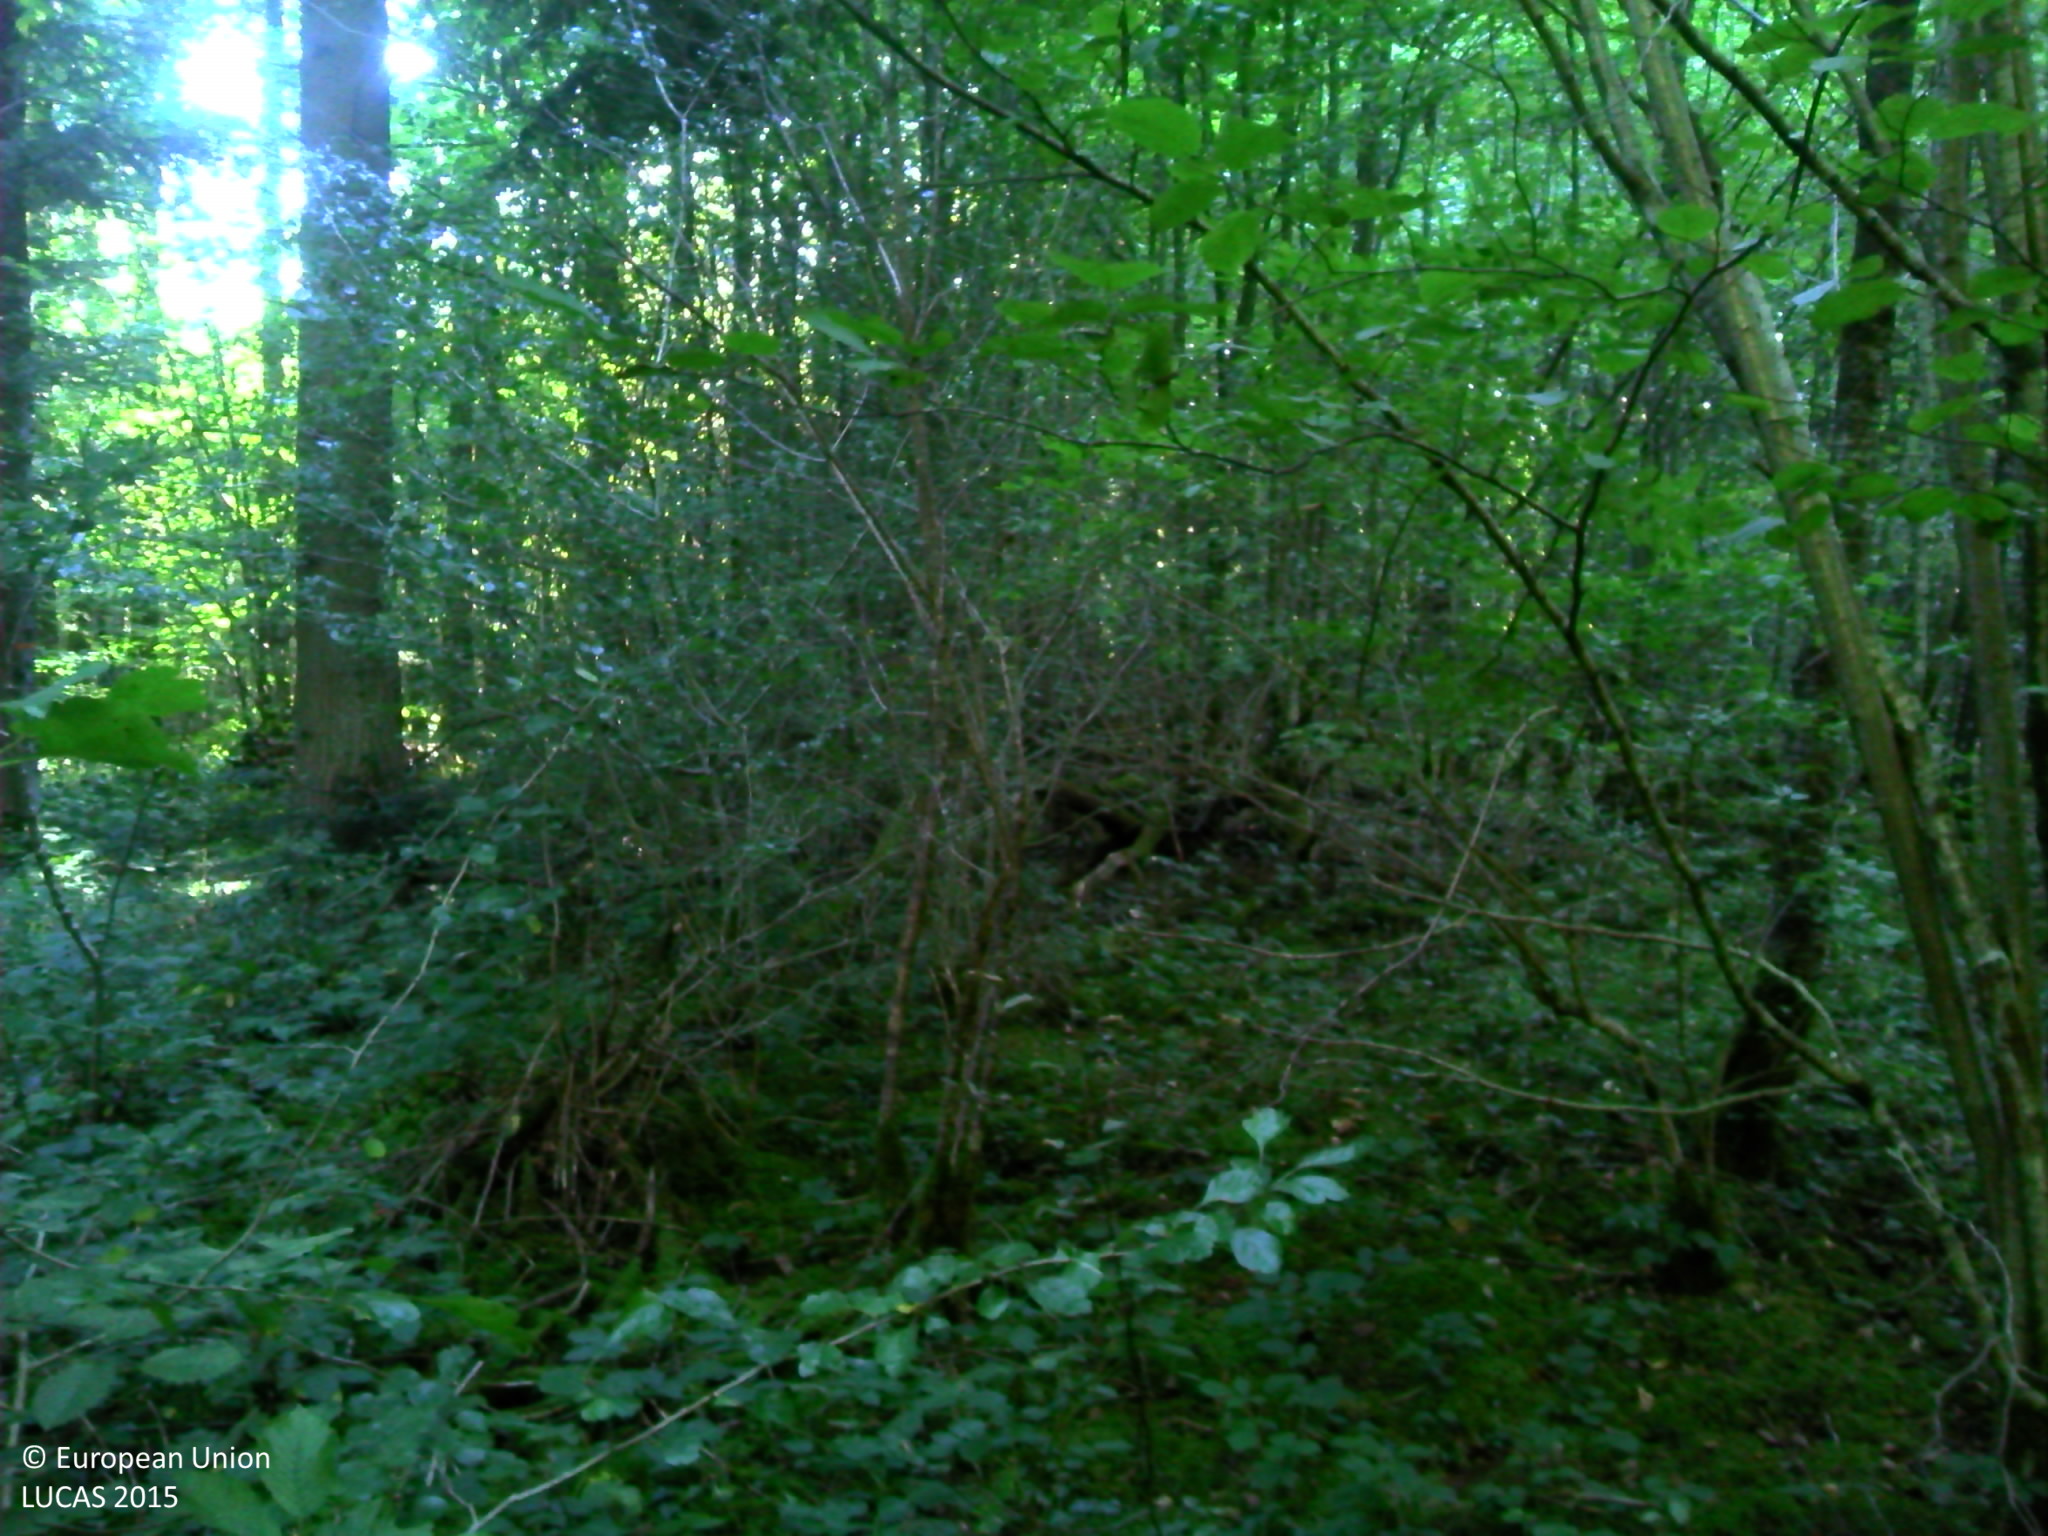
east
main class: Woodland
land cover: Spruce dominated mixed woodland
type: mesophytic deciduous forest
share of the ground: > 75 %
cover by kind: coniferous forest trees 40 %, broadleaved forest trees 40 %, shrubs 5 %, herbaceous plants 5 %, lichens and mosses 5 %, consolidated bare surface 5 %
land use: Forestry
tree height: > 5 m
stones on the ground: < 10 %
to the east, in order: Spruce dominated mixed woodland; Broadleaved woodland; Spruce dominated coniferous woodland; Broadleaved woodland; Tracks; Broadleaved woodland
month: September
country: FR
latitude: 47.2782
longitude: 6.2871
